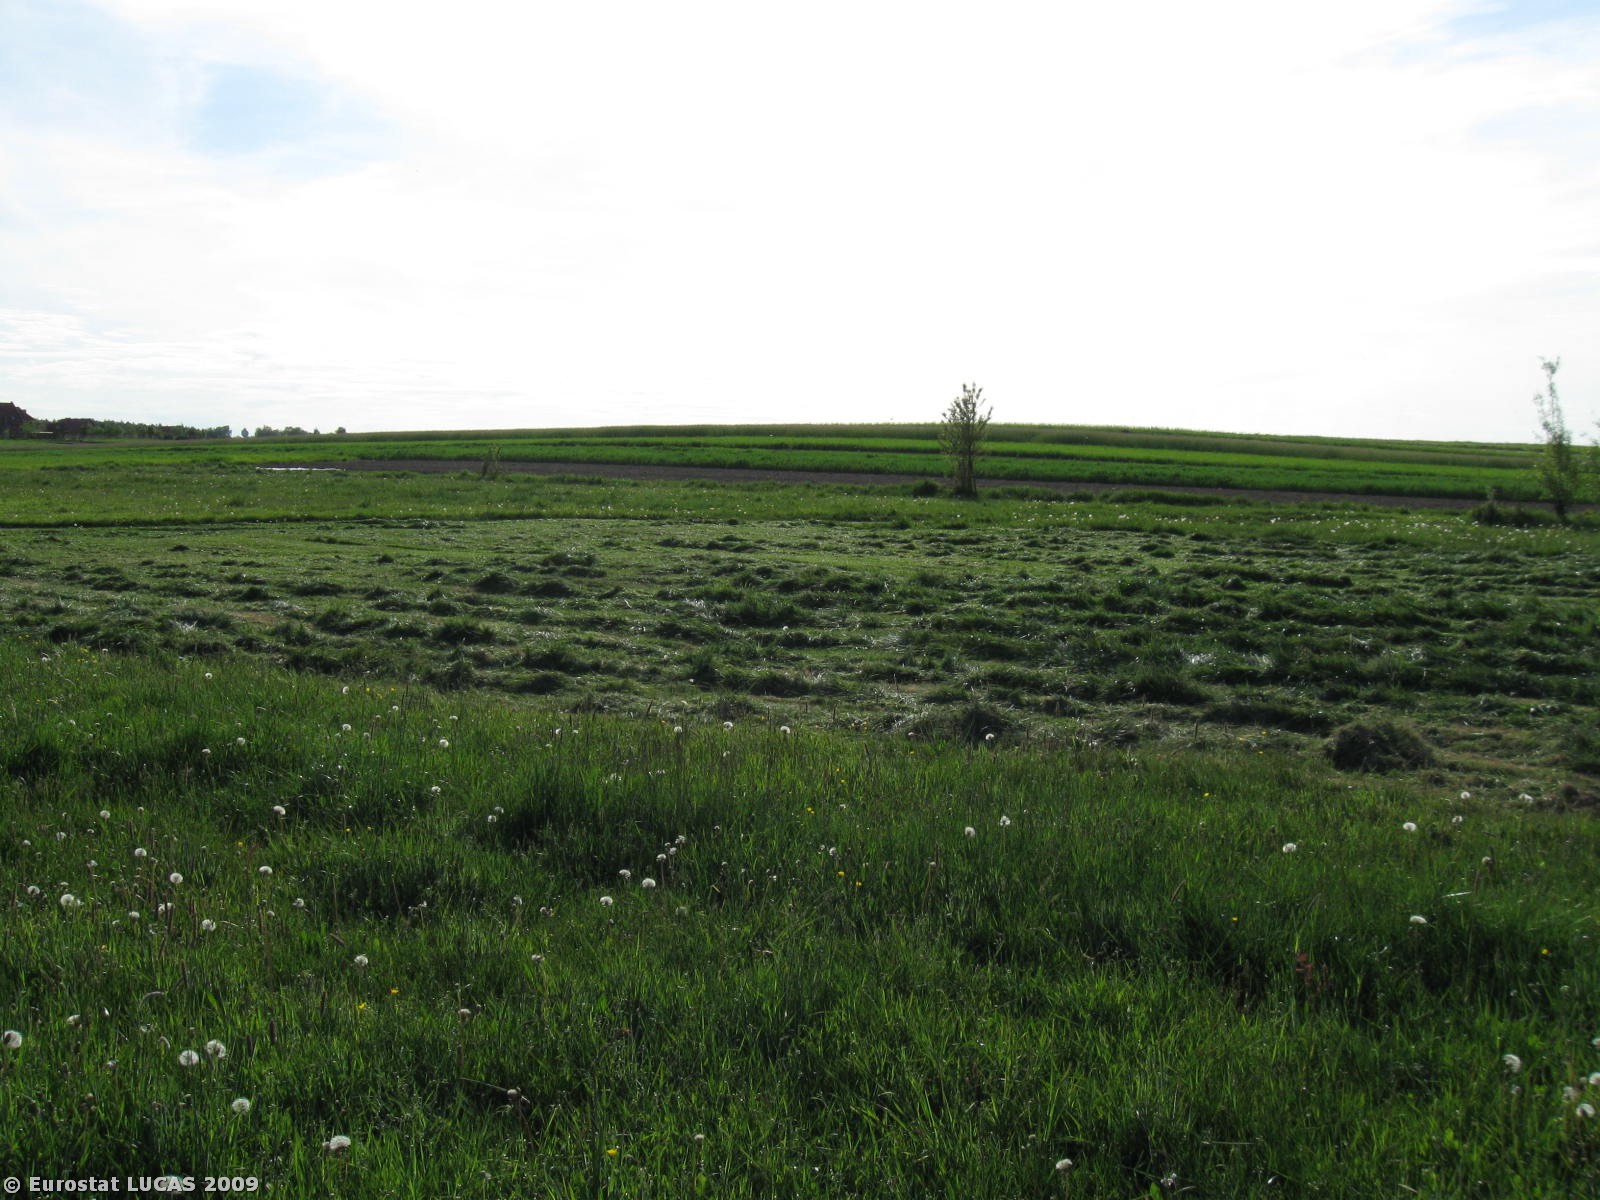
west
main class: Grassland
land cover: Grassland without tree/shrub cover
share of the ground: > 75 %
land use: Agriculture (excluding fallow land and kitchen gardens)
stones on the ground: < 10 %
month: May
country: PL
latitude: 50.8960
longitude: 20.4883
